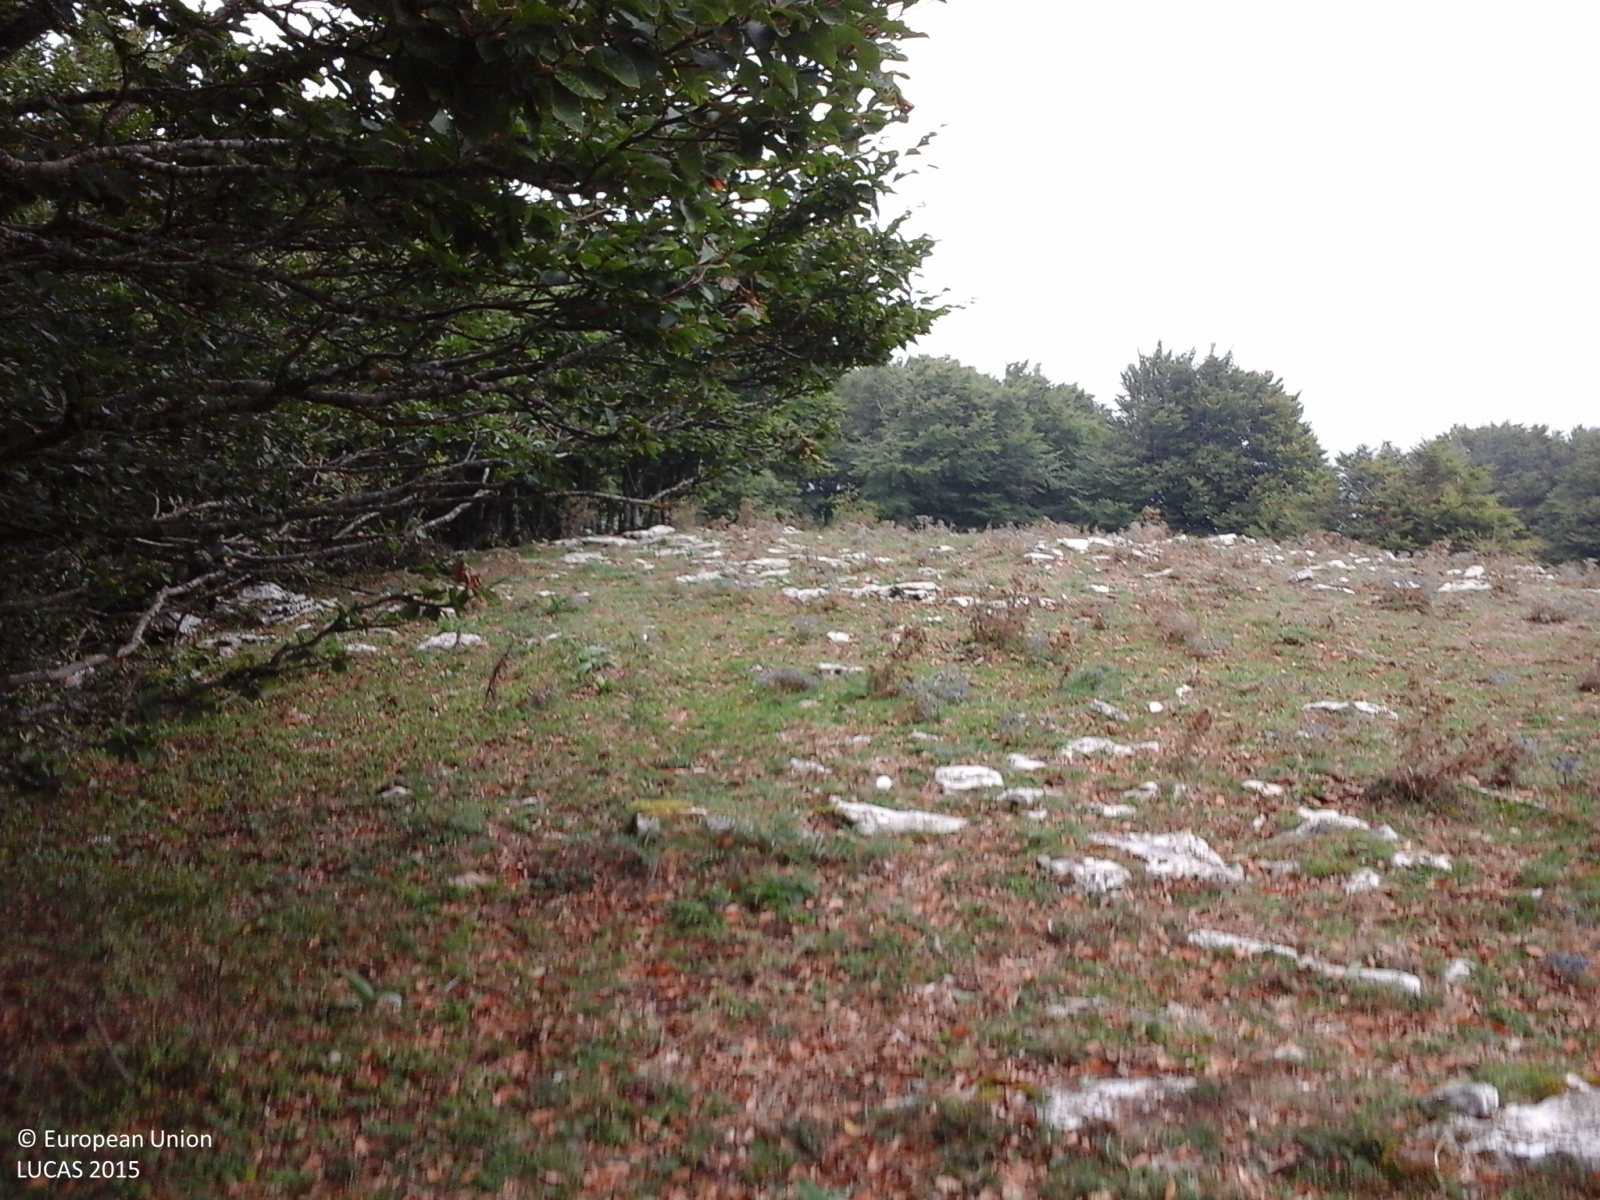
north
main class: Woodland
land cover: Broadleaved woodland
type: mountainous beech forest
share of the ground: > 75 %
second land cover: Grassland without tree/shrub cover
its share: > 75 %
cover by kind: broadleaved forest trees 70 %, shrubs 20 %, herbaceous plants 10 %
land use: Forestry
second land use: Agriculture (excluding fallow land and kitchen gardens)
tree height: > 5 m
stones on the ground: 25 - 50 %
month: September
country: IT
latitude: 41.6362
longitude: 14.3903
